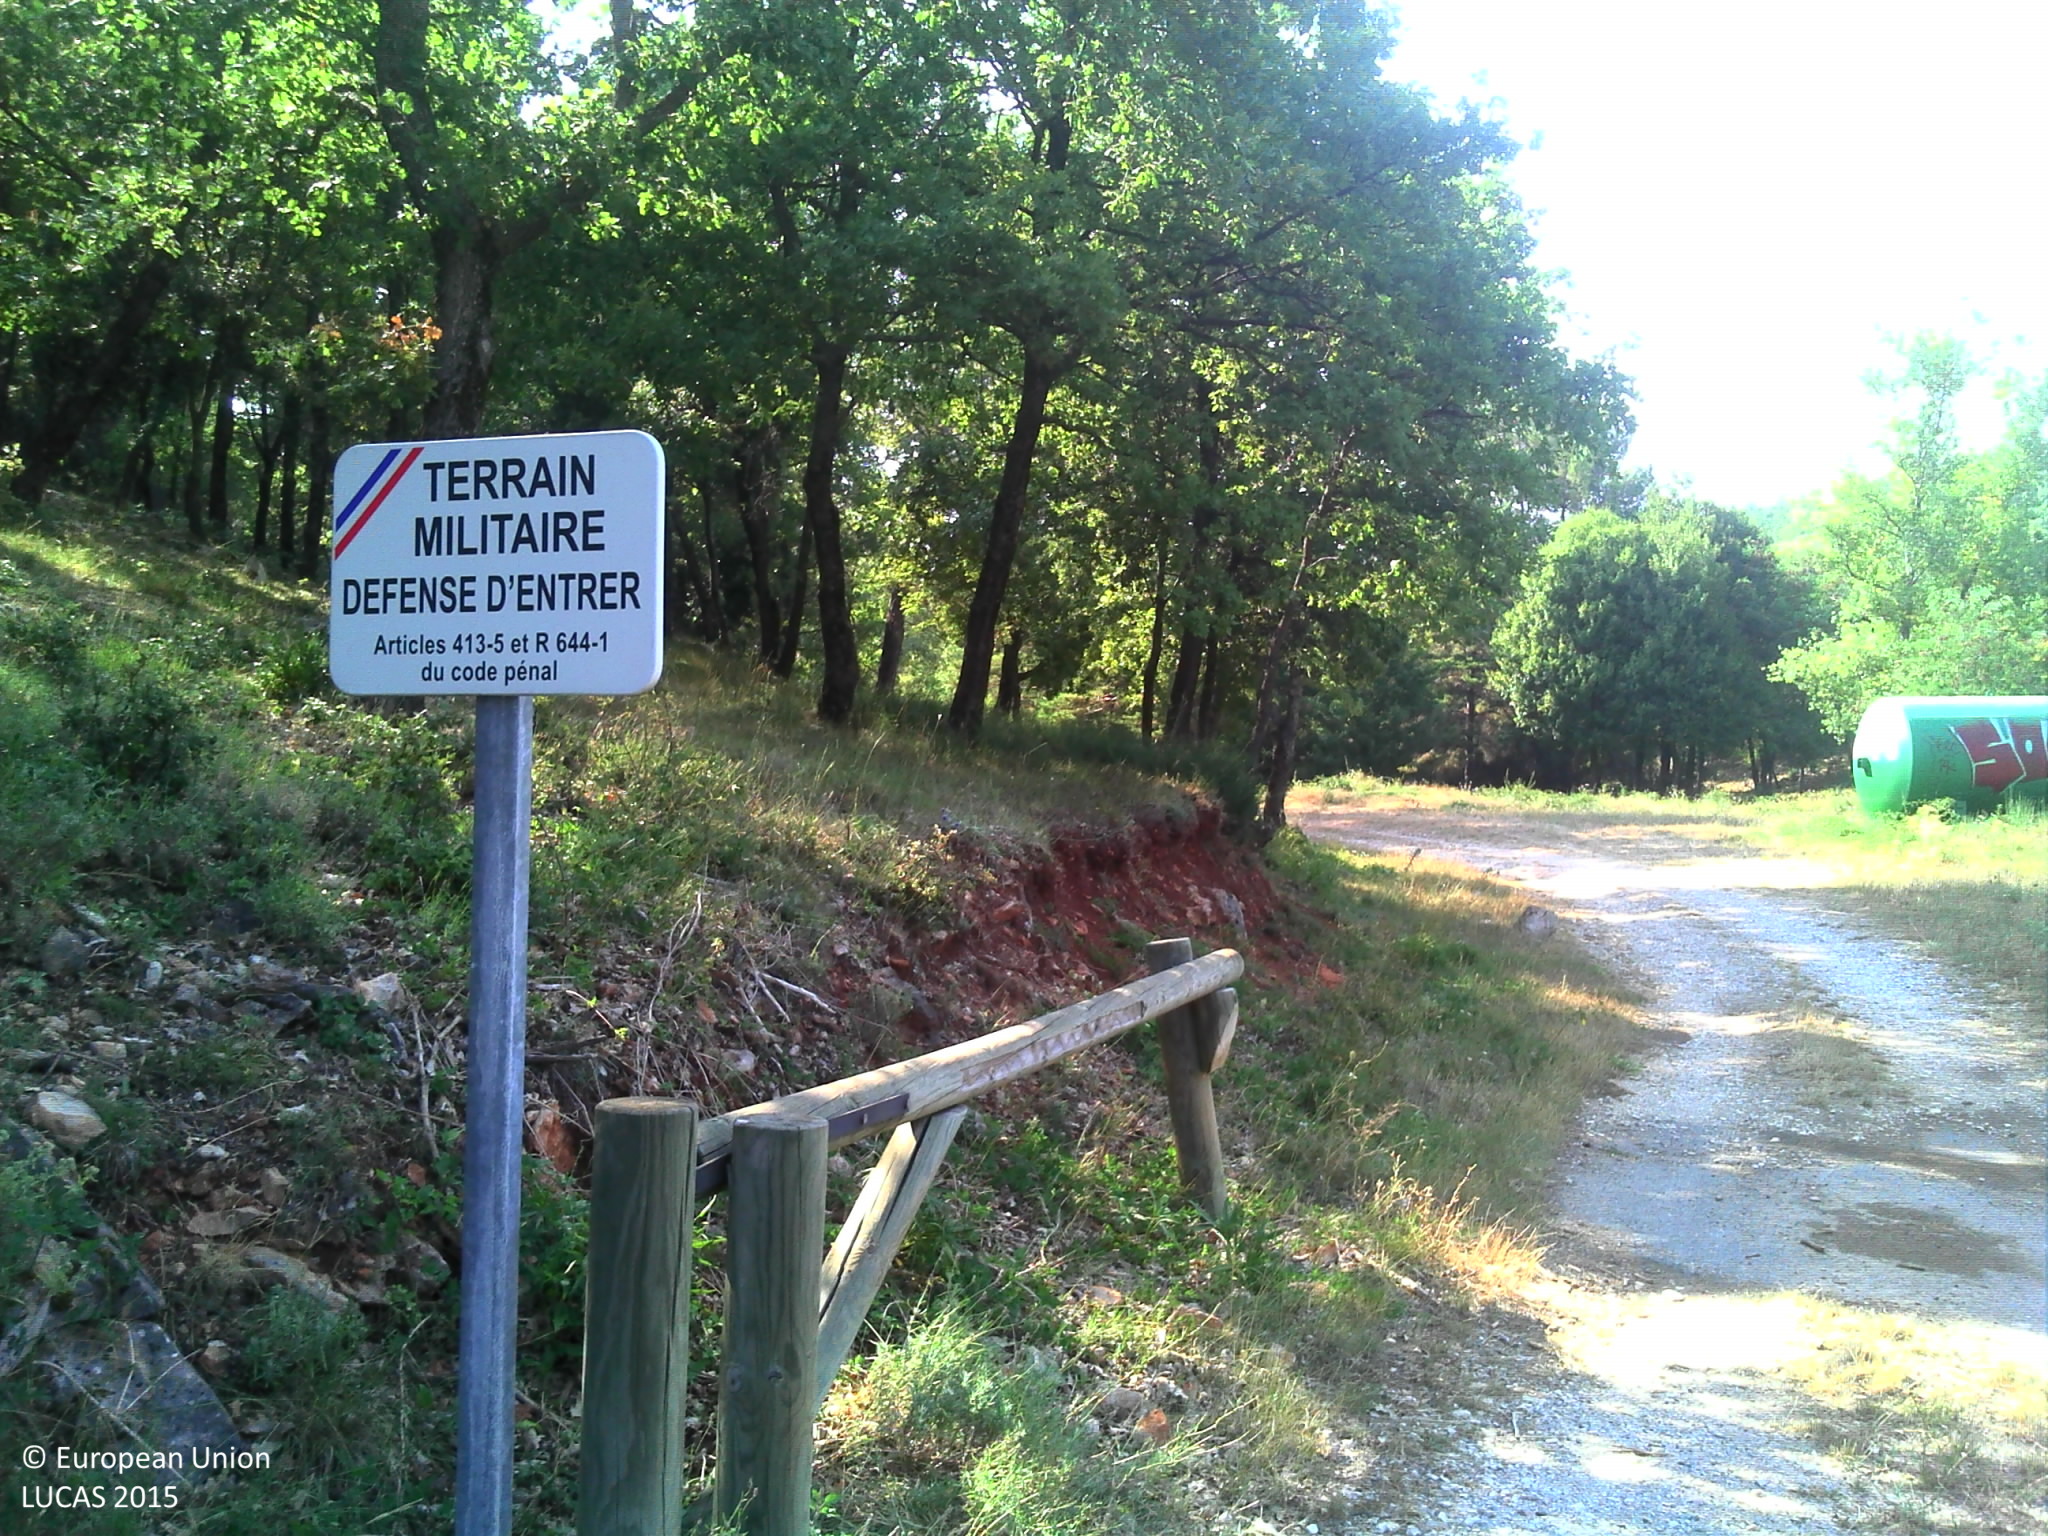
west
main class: Shrubland
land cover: Shrubland with sparse tree cover
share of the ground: > 75 %
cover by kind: shrubs 85 %, unconsolidated bare surface 10 %, broadleaved forest trees 5 %
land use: Community services
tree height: < 5 m
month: August
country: FR
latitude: 43.6415
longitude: 6.5000
